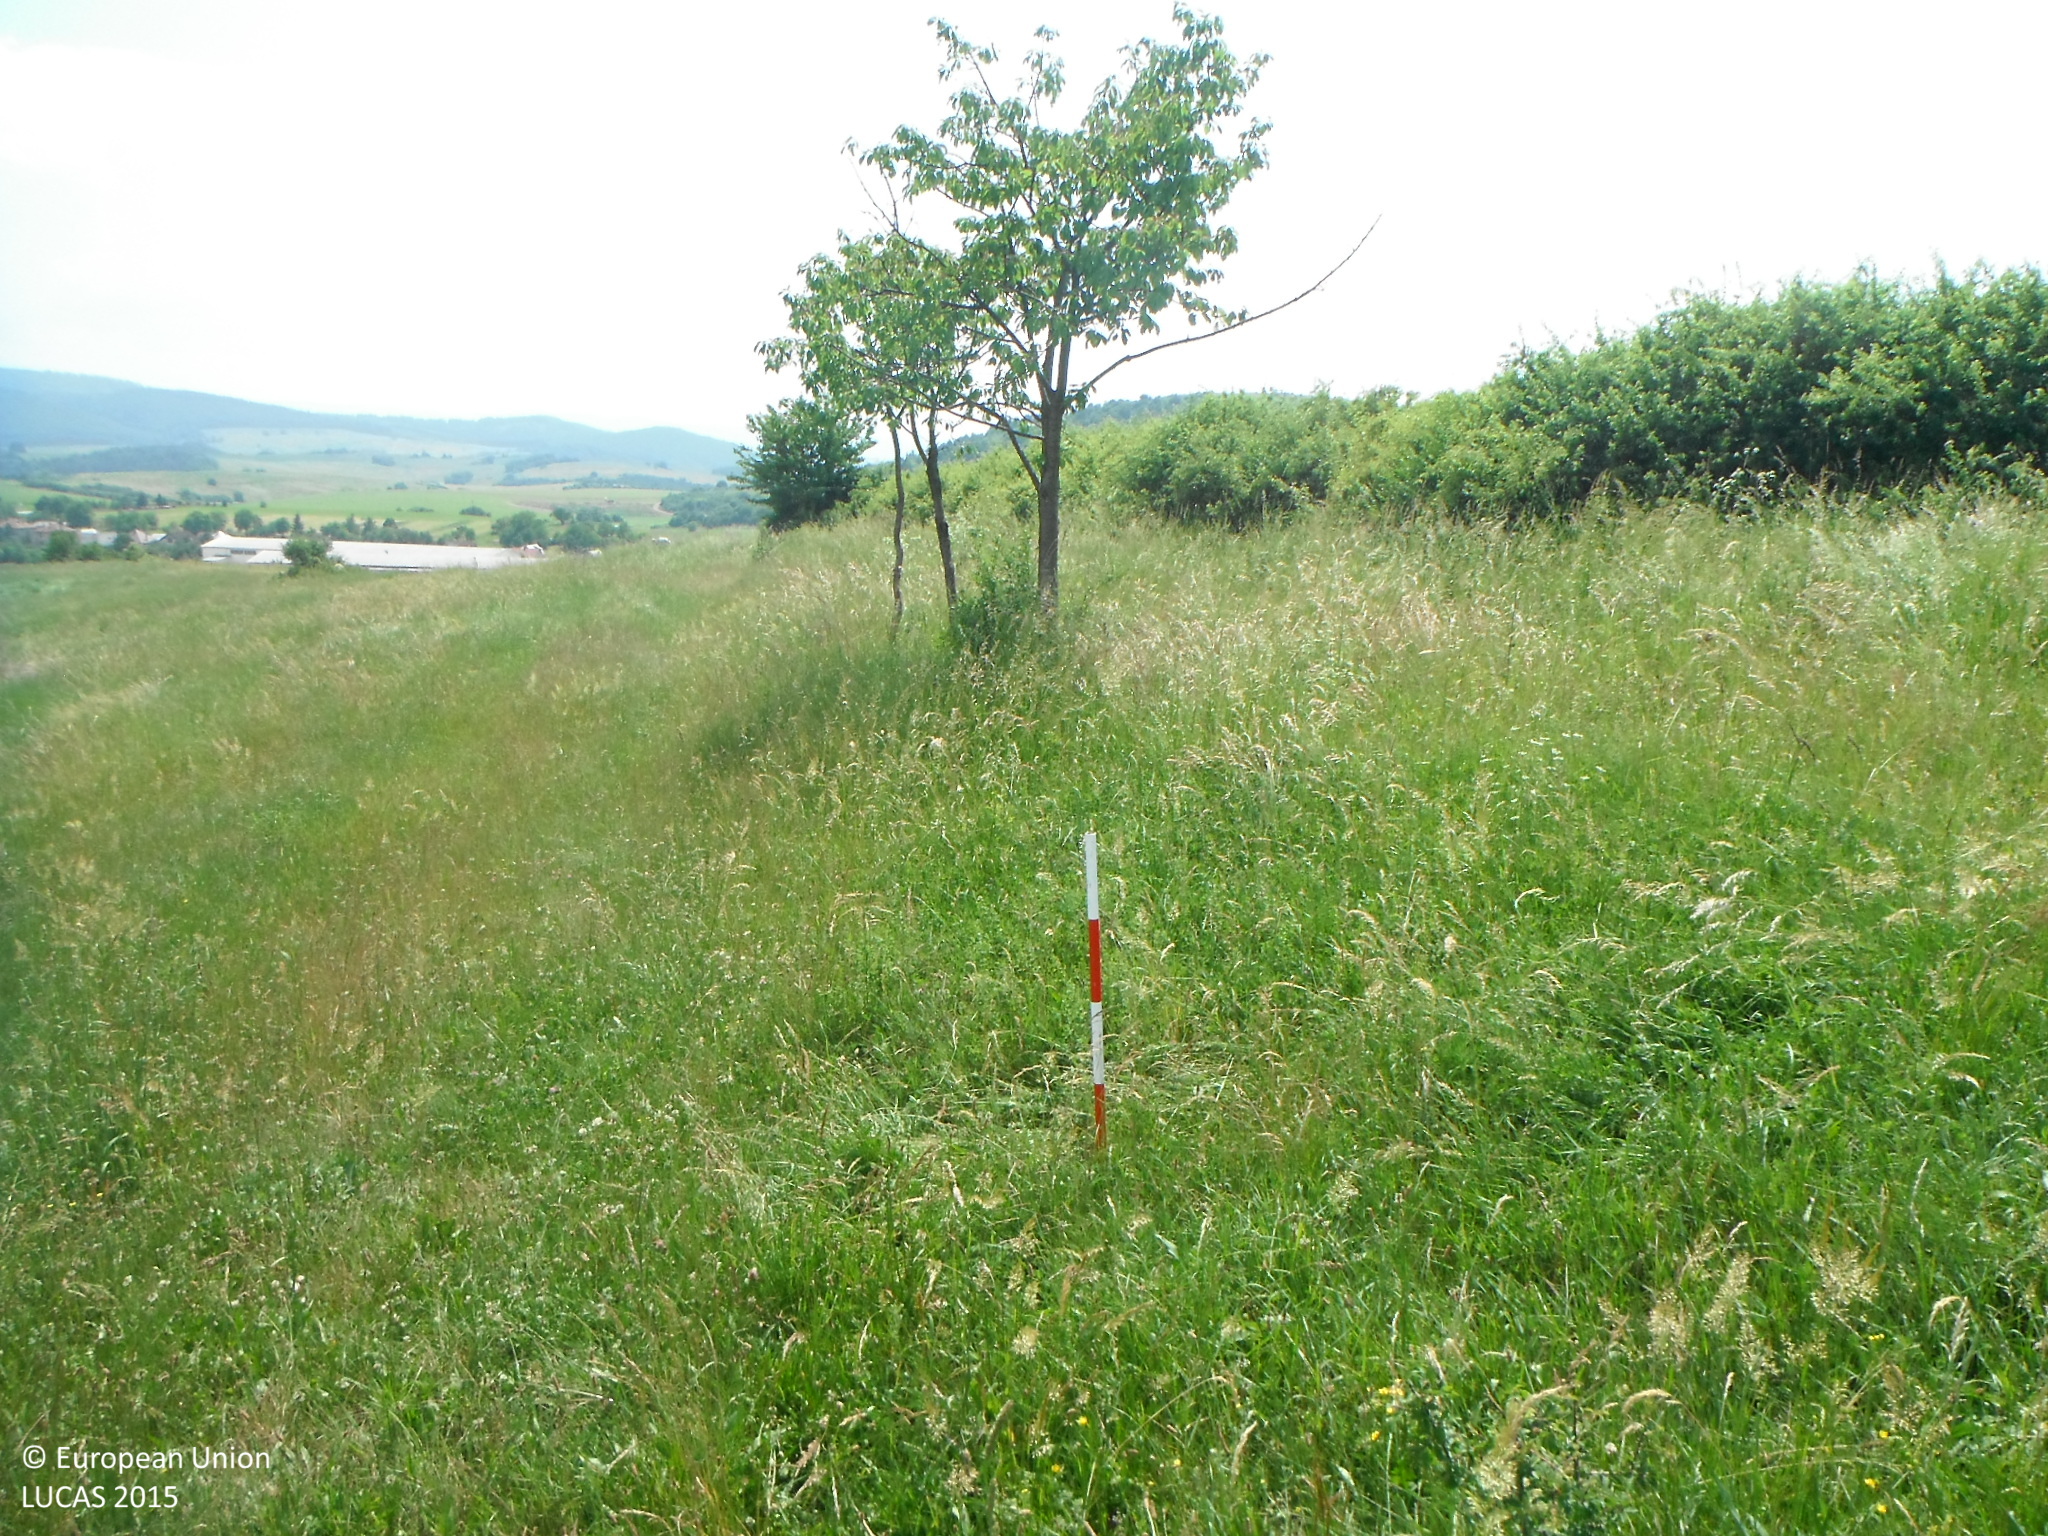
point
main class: Grassland
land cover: Grassland without tree/shrub cover
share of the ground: > 75 %
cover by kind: herbaceous plants 100 %
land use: Agriculture (excluding fallow land and kitchen gardens)
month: June
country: SK
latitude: 48.7188
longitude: 19.2798
